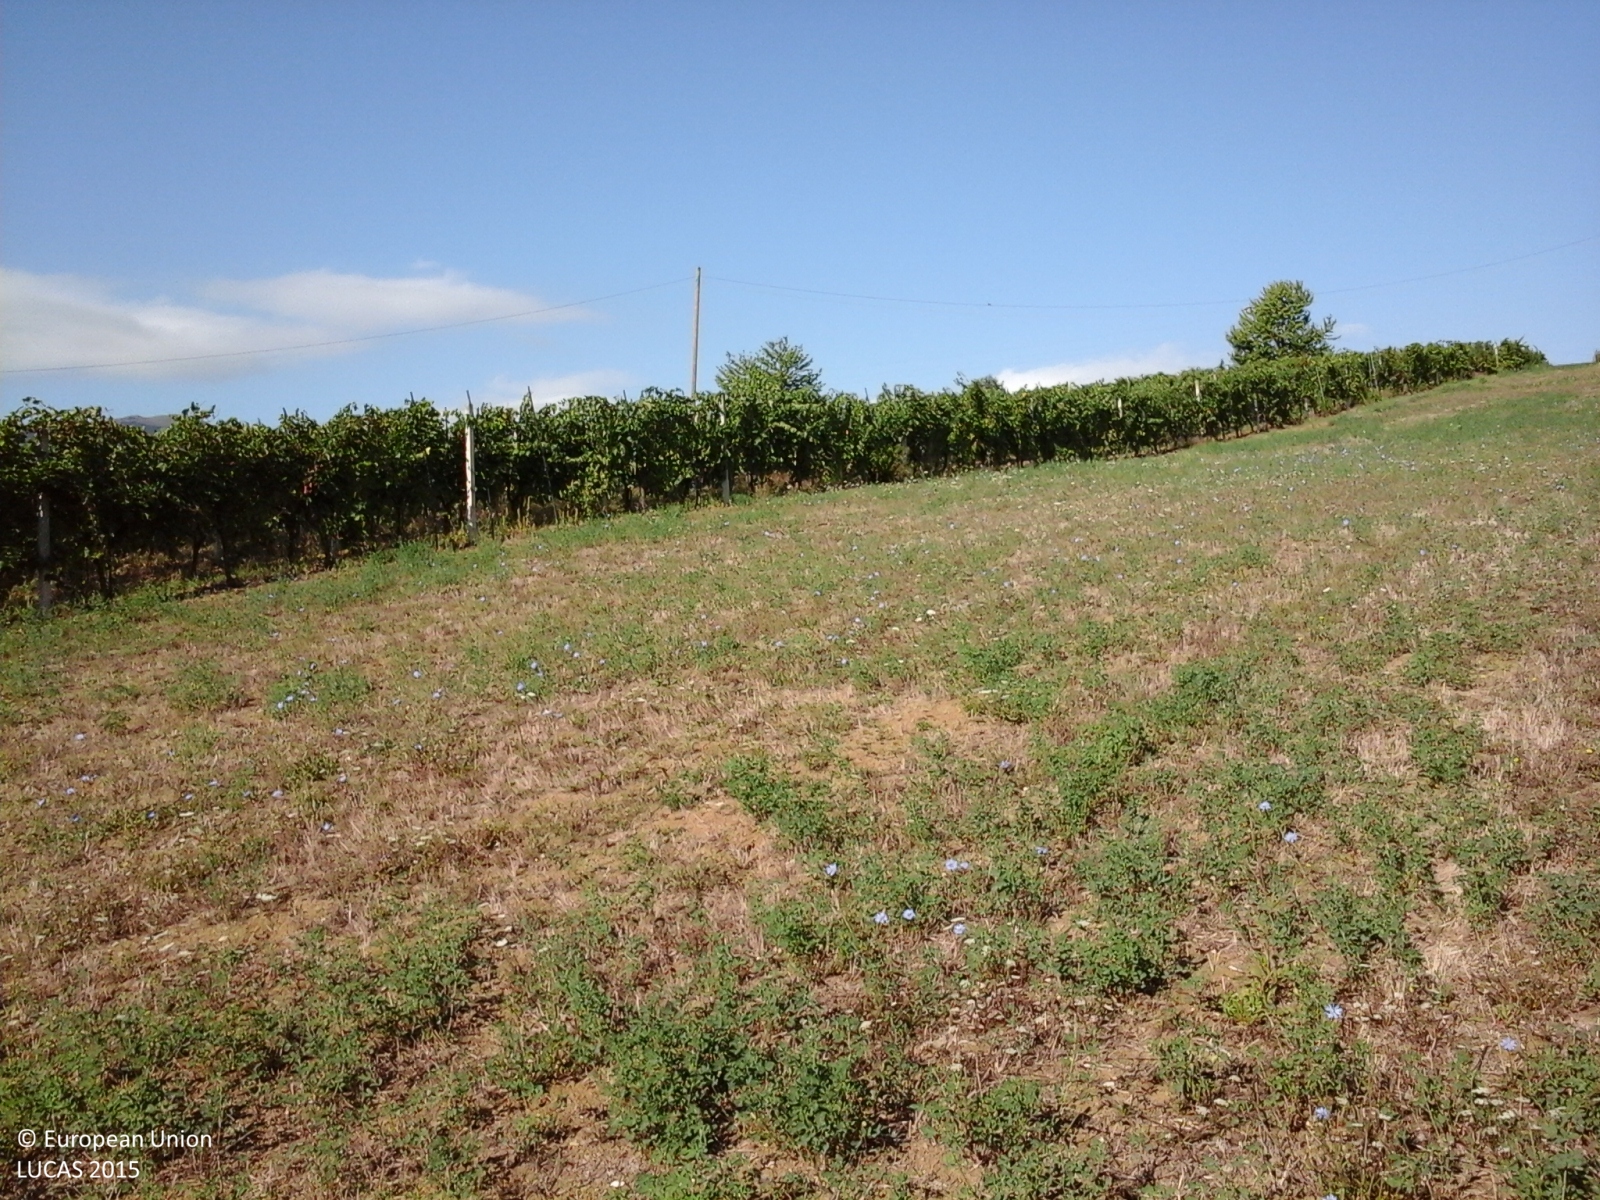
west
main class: Cropland
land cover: Clovers
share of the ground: > 75 %
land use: Agriculture (excluding fallow land and kitchen gardens)
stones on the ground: 10 - 25 %
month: September
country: IT
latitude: 43.2417
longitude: 13.0091
